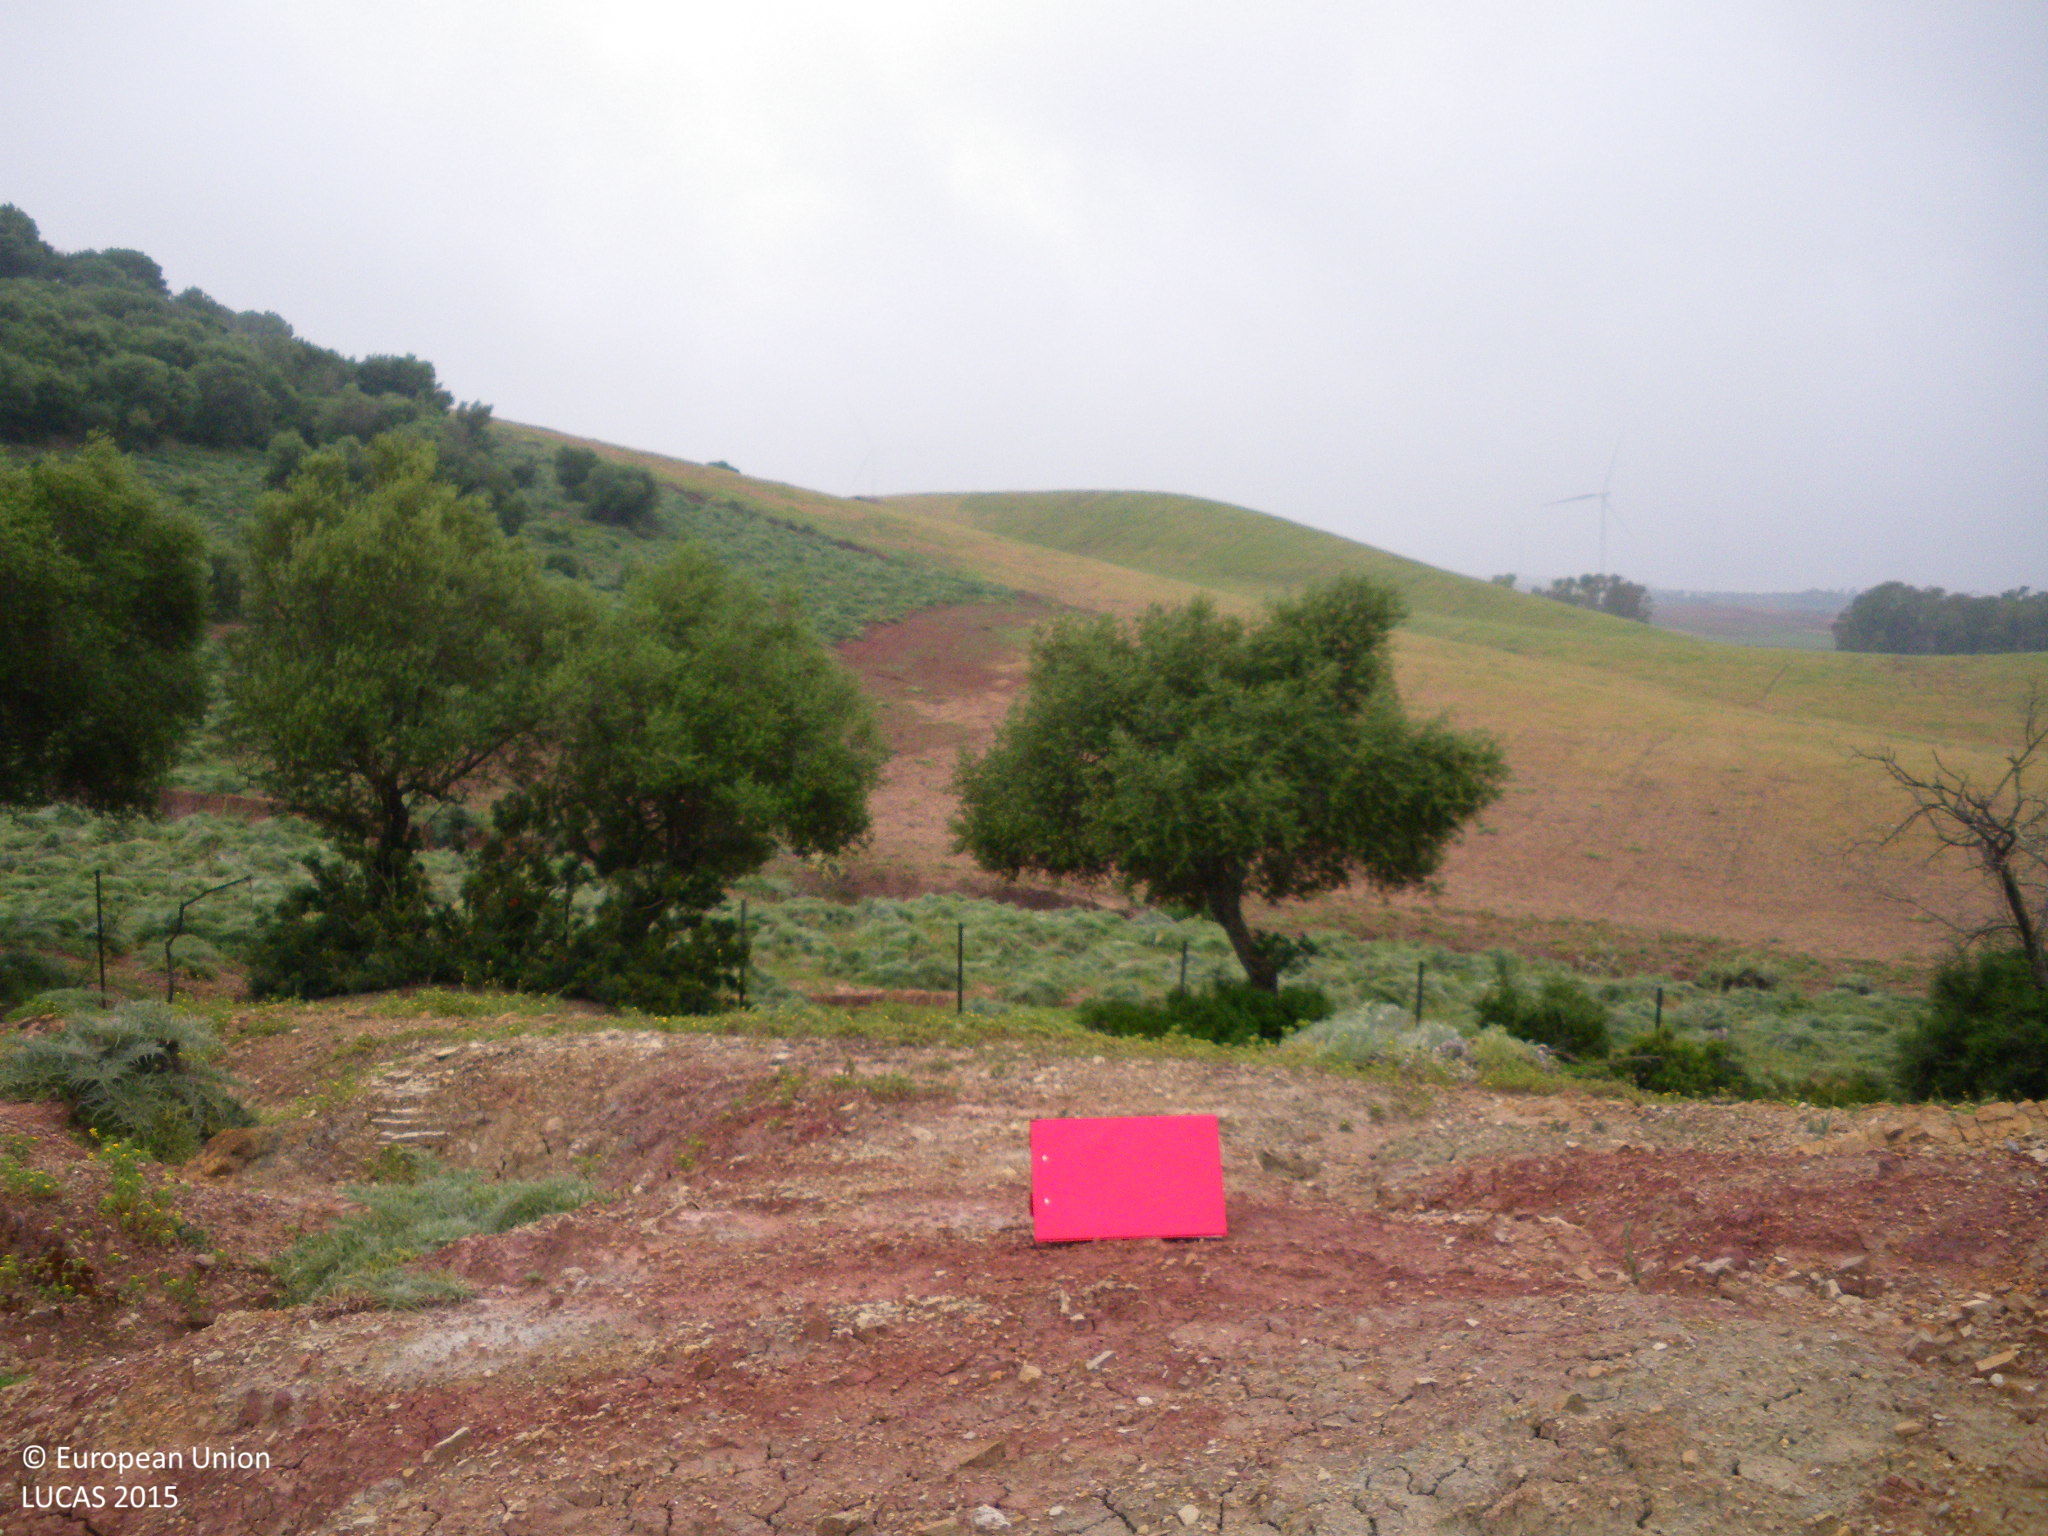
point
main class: Woodland
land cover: Broadleaved woodland
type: broadleaved evergreen forest
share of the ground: 10 - 25 %
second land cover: Grassland without tree/shrub cover
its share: 25 - 50 %
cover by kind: unconsolidated bare surface 50 %, herbaceous plants 30 %, broadleaved forest trees 15 %, shrubs 5 %
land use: Forestry
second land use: Agriculture (excluding fallow land and kitchen gardens)
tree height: > 5 m
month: April
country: ES
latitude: 36.5261
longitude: -5.9202
